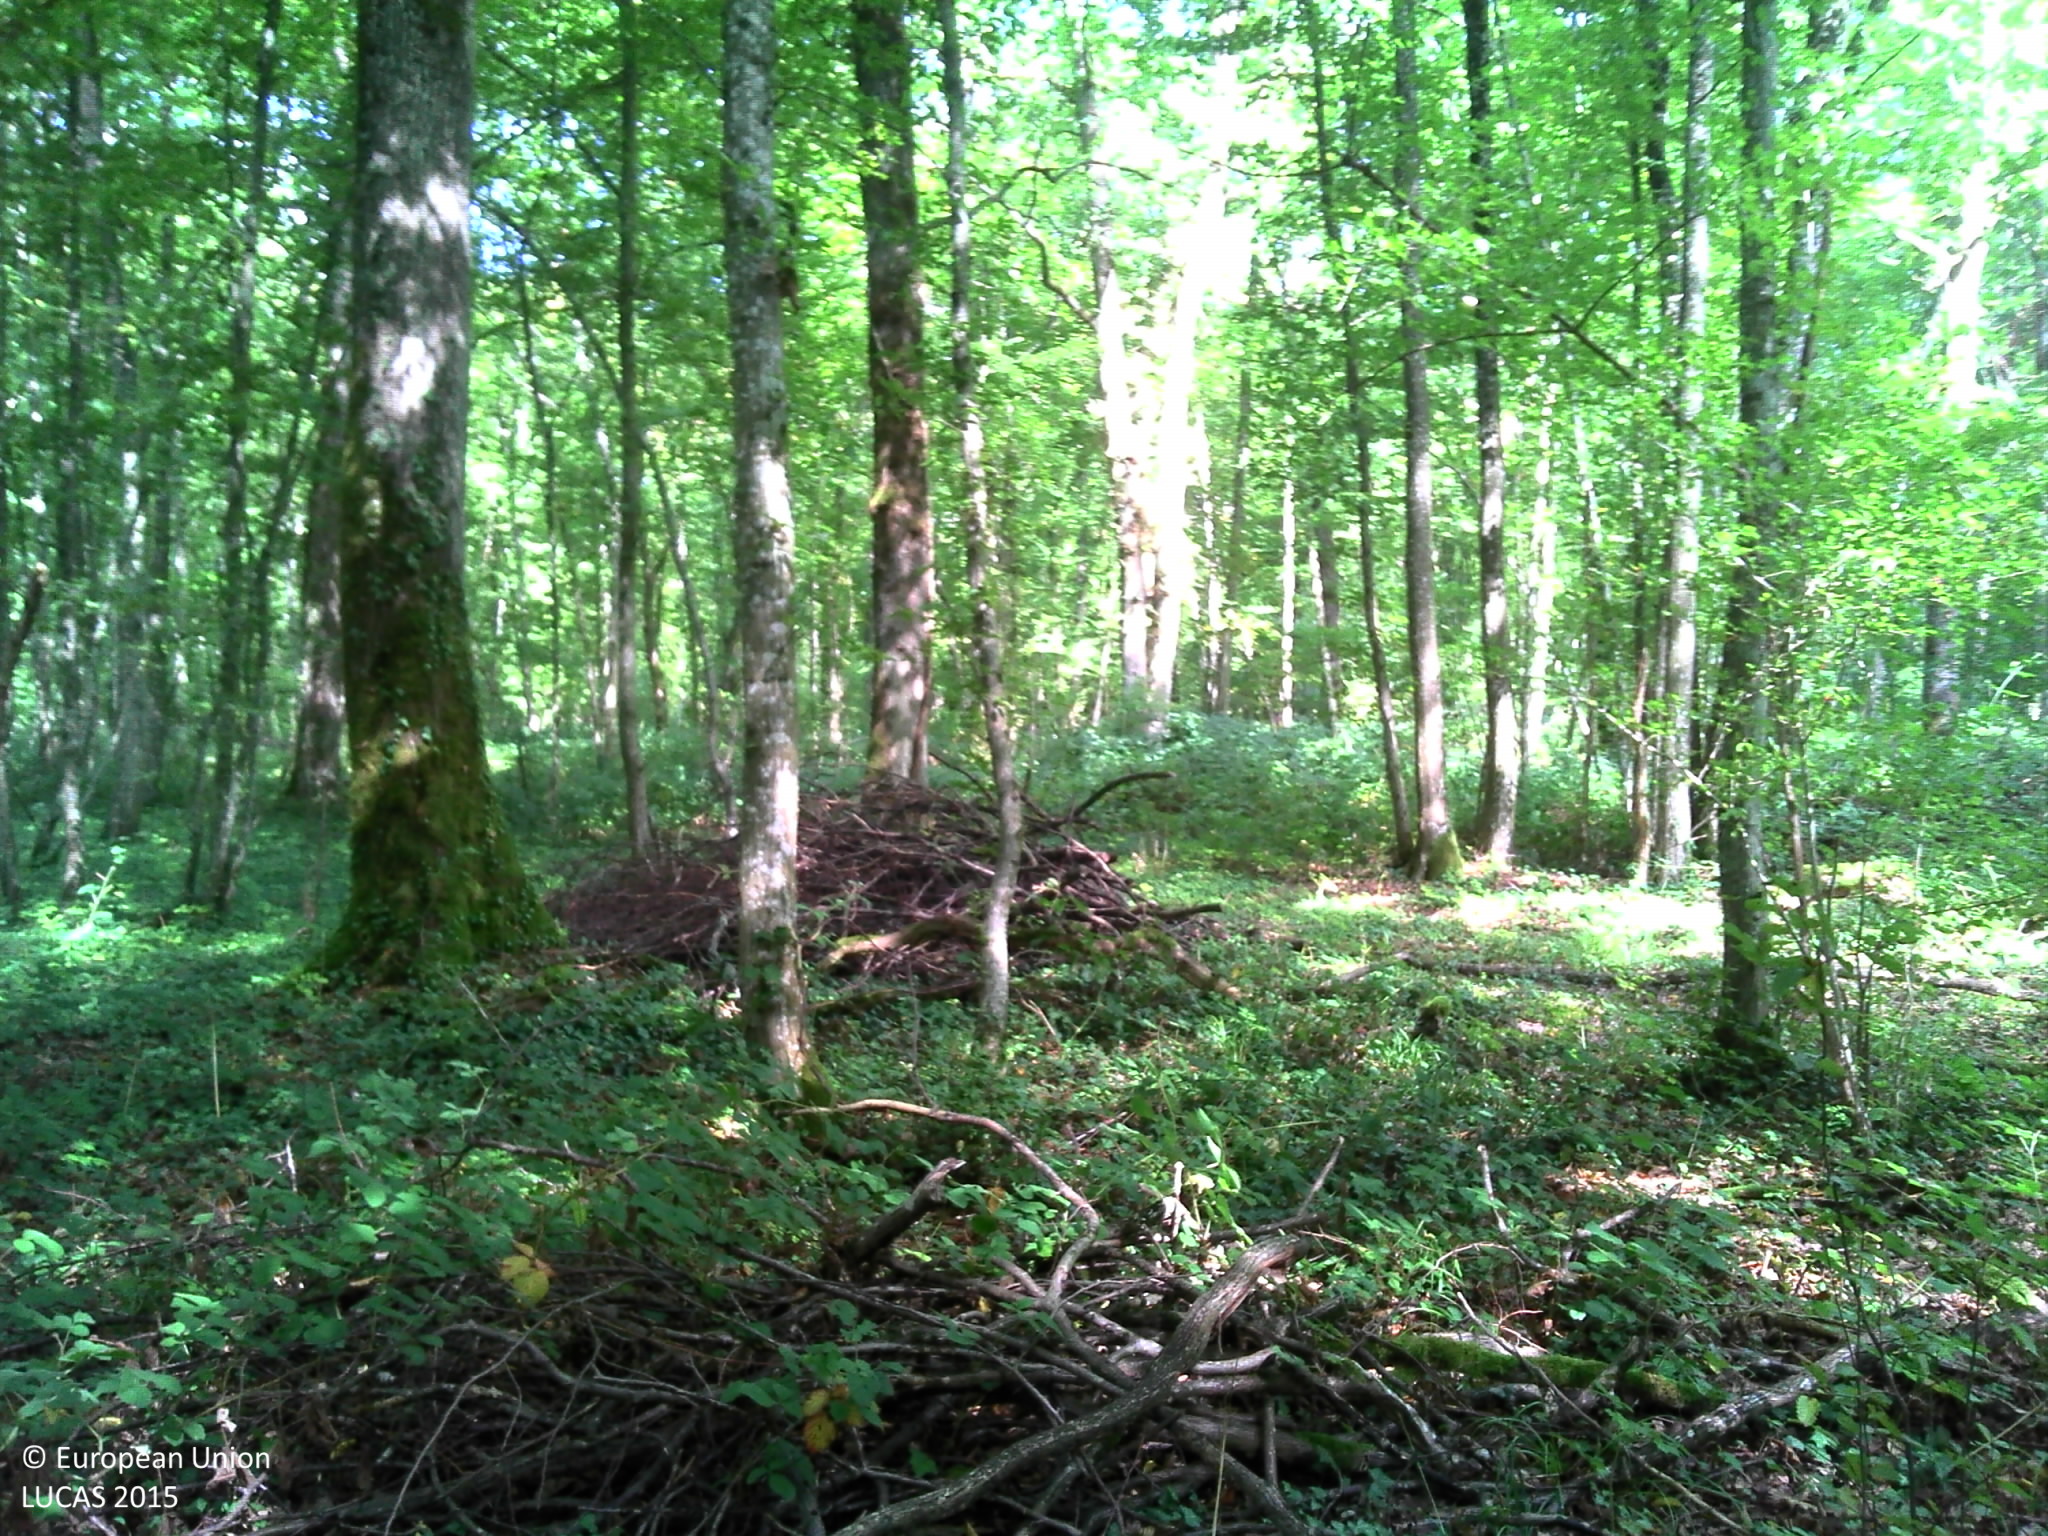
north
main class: Woodland
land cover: Broadleaved woodland
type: mesophytic deciduous forest
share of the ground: > 75 %
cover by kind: broadleaved forest trees 85 %, herbaceous plants 10 %, consolidated bare surface 5 %
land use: Forestry
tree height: > 5 m
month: September
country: FR
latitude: 48.7819
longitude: 6.0122
